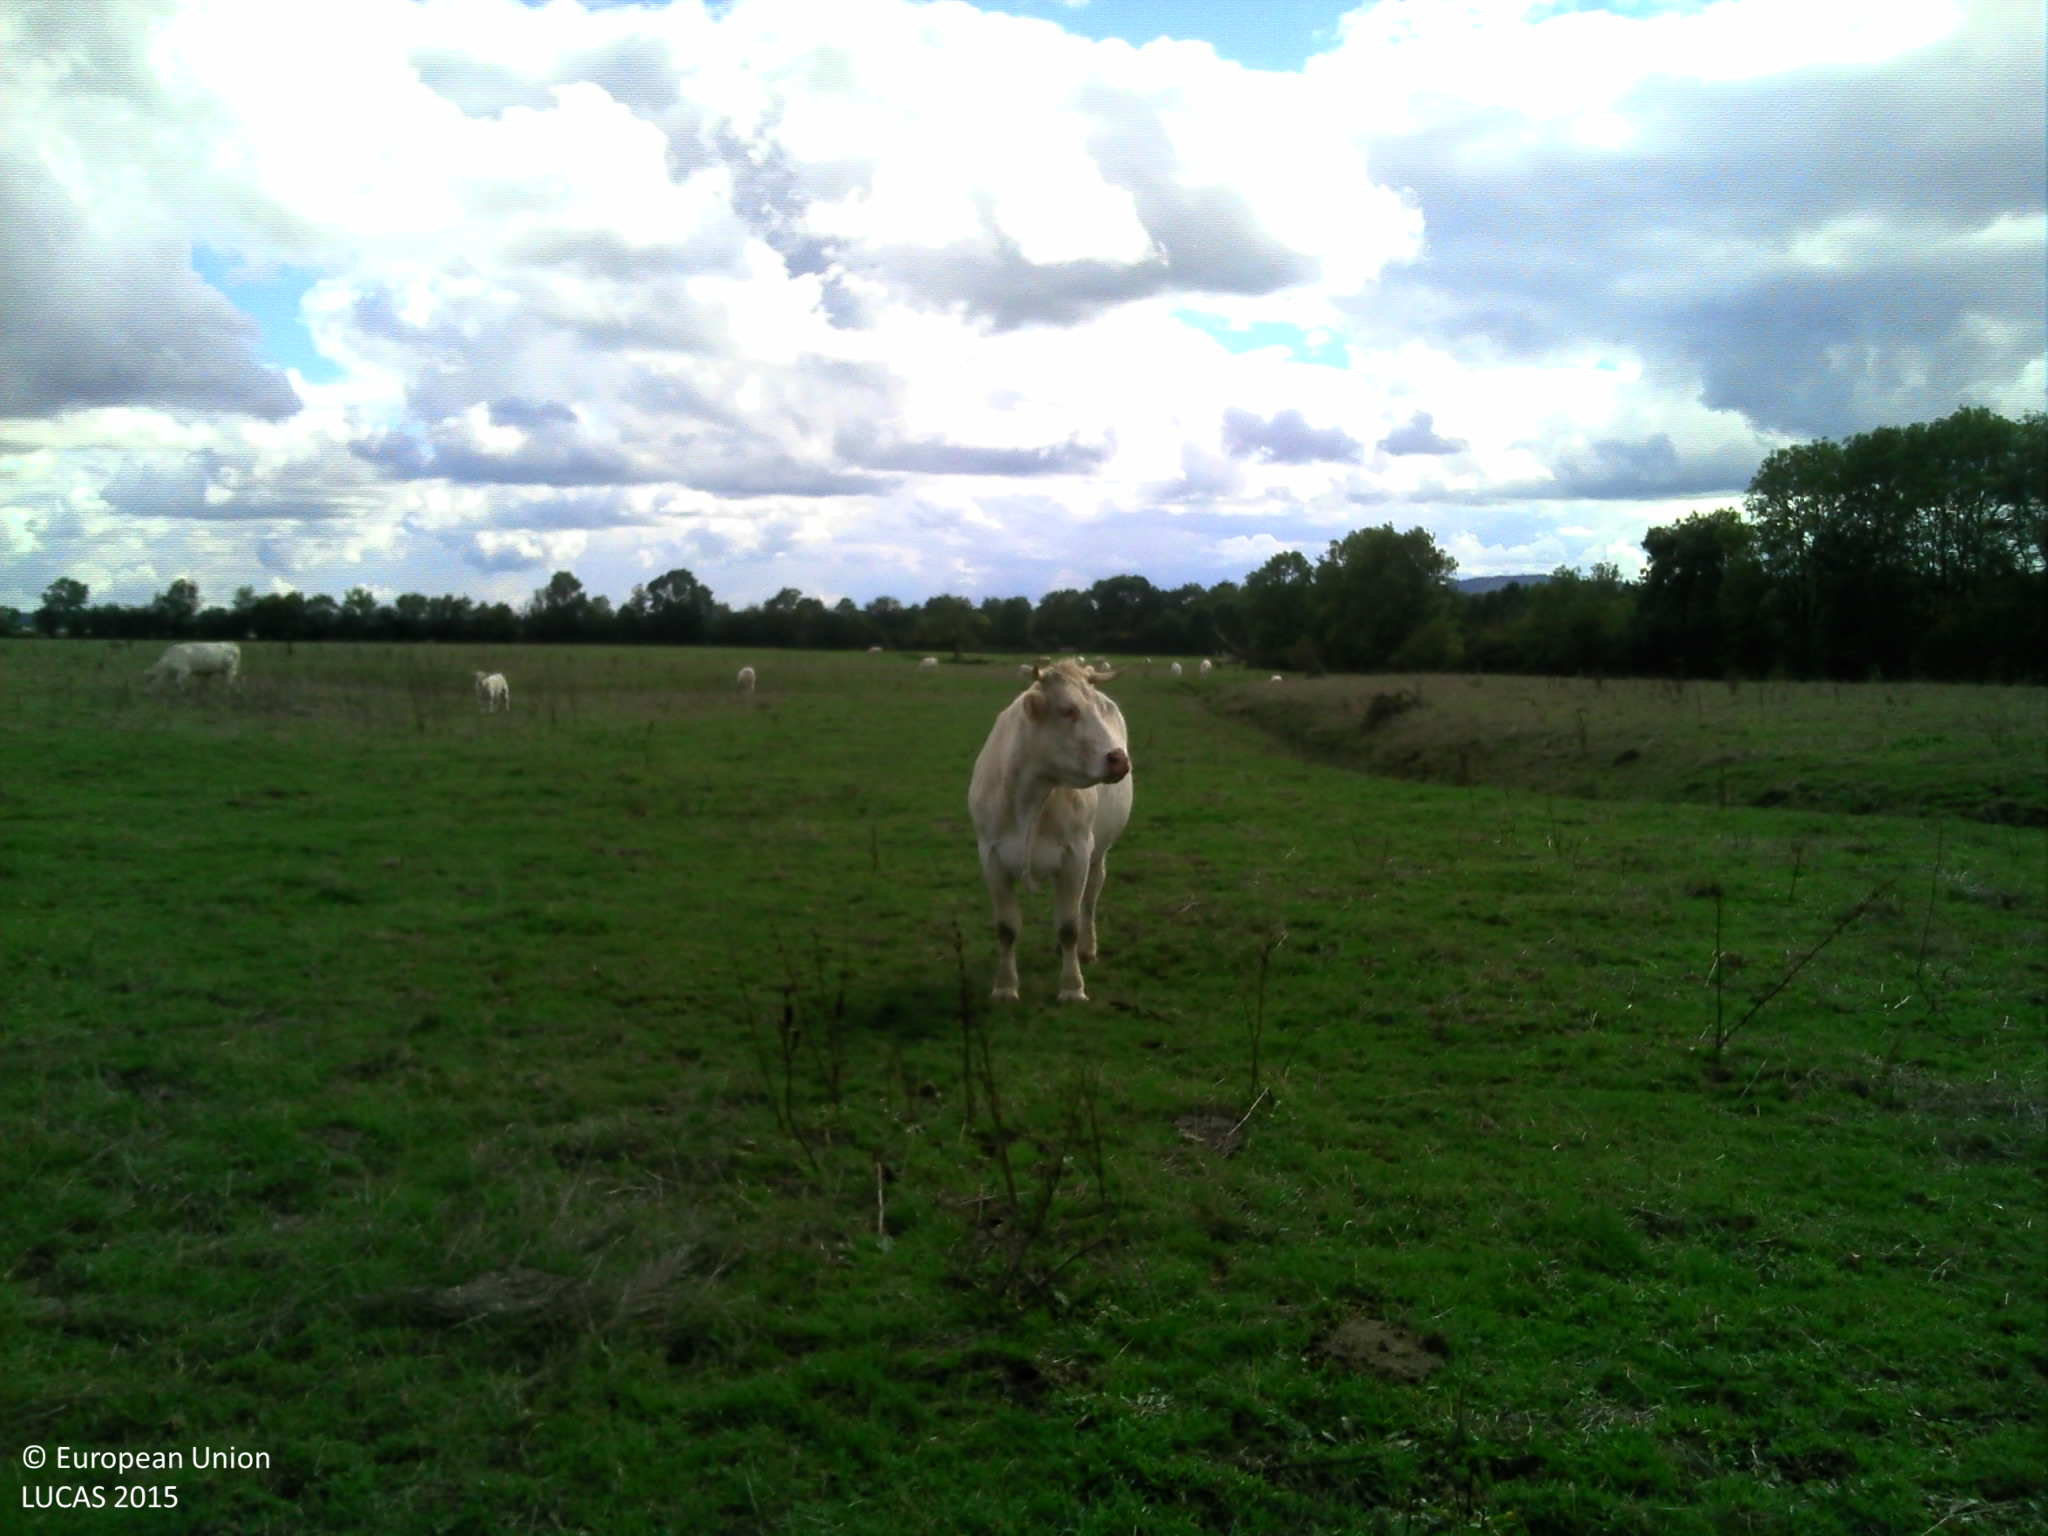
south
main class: Grassland
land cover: Grassland without tree/shrub cover
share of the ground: > 75 %
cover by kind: herbaceous plants 100 %
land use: Agriculture (excluding fallow land and kitchen gardens)
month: September
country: FR
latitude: 47.2133
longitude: 4.3614
